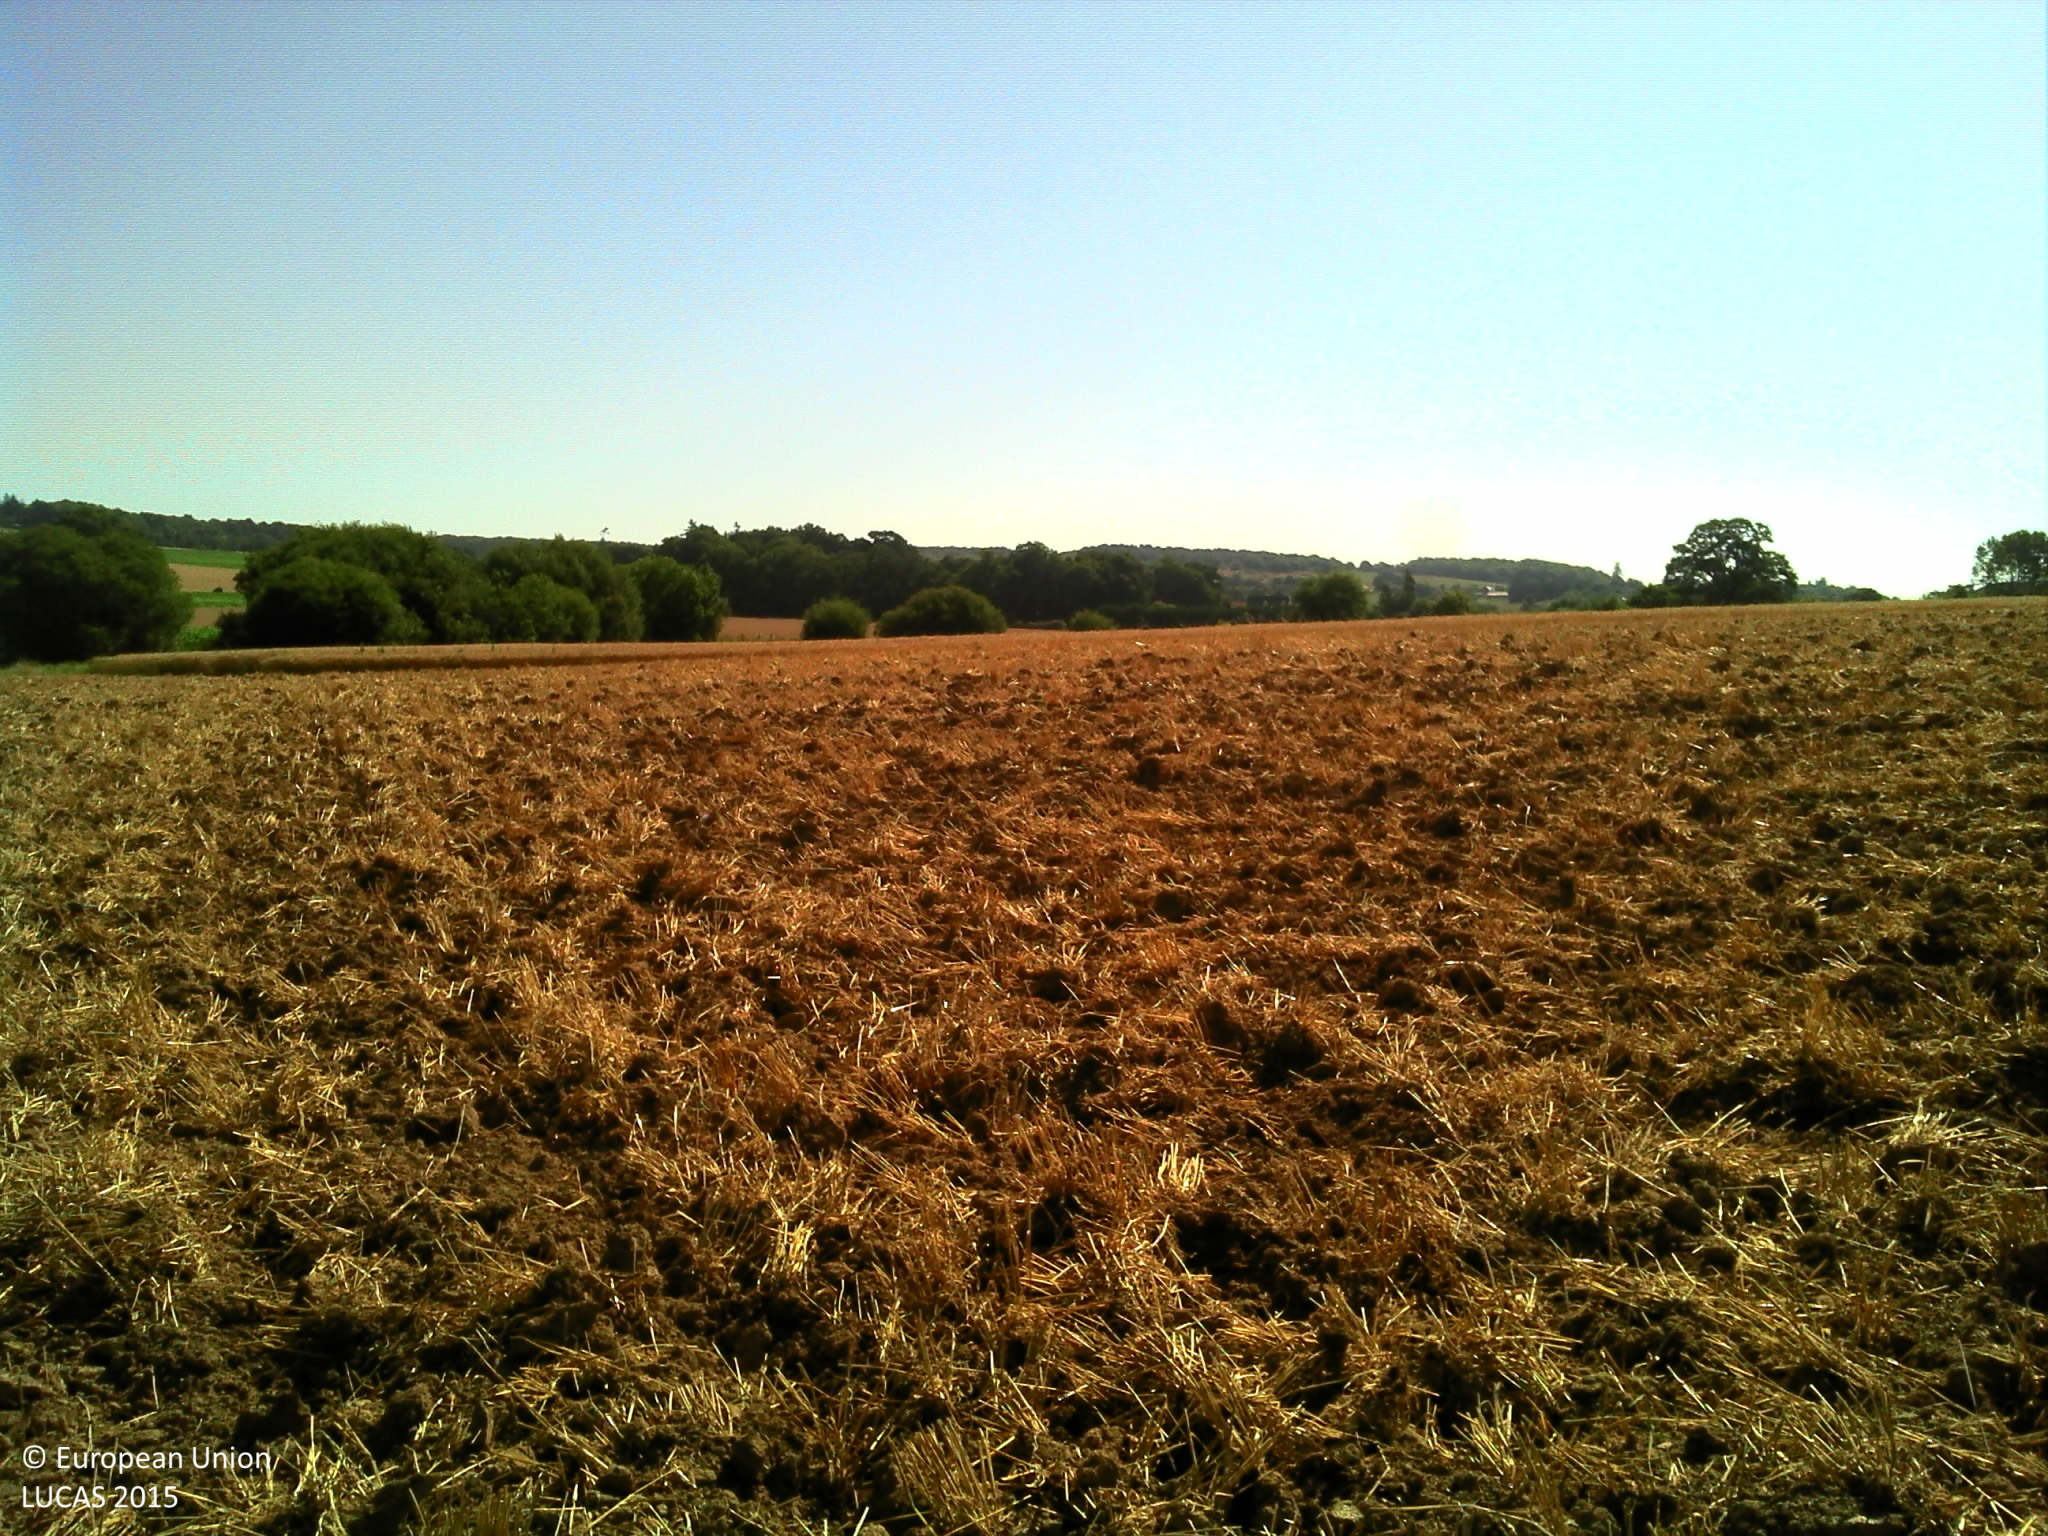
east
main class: Cropland
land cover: Barley
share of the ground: 10 - 25 %
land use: Agriculture (excluding fallow land and kitchen gardens)
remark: Harvested field
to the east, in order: Barley; Common wheat; Grassland without tree/shrub cover
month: July
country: FR
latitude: 47.8723
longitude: -1.8548
